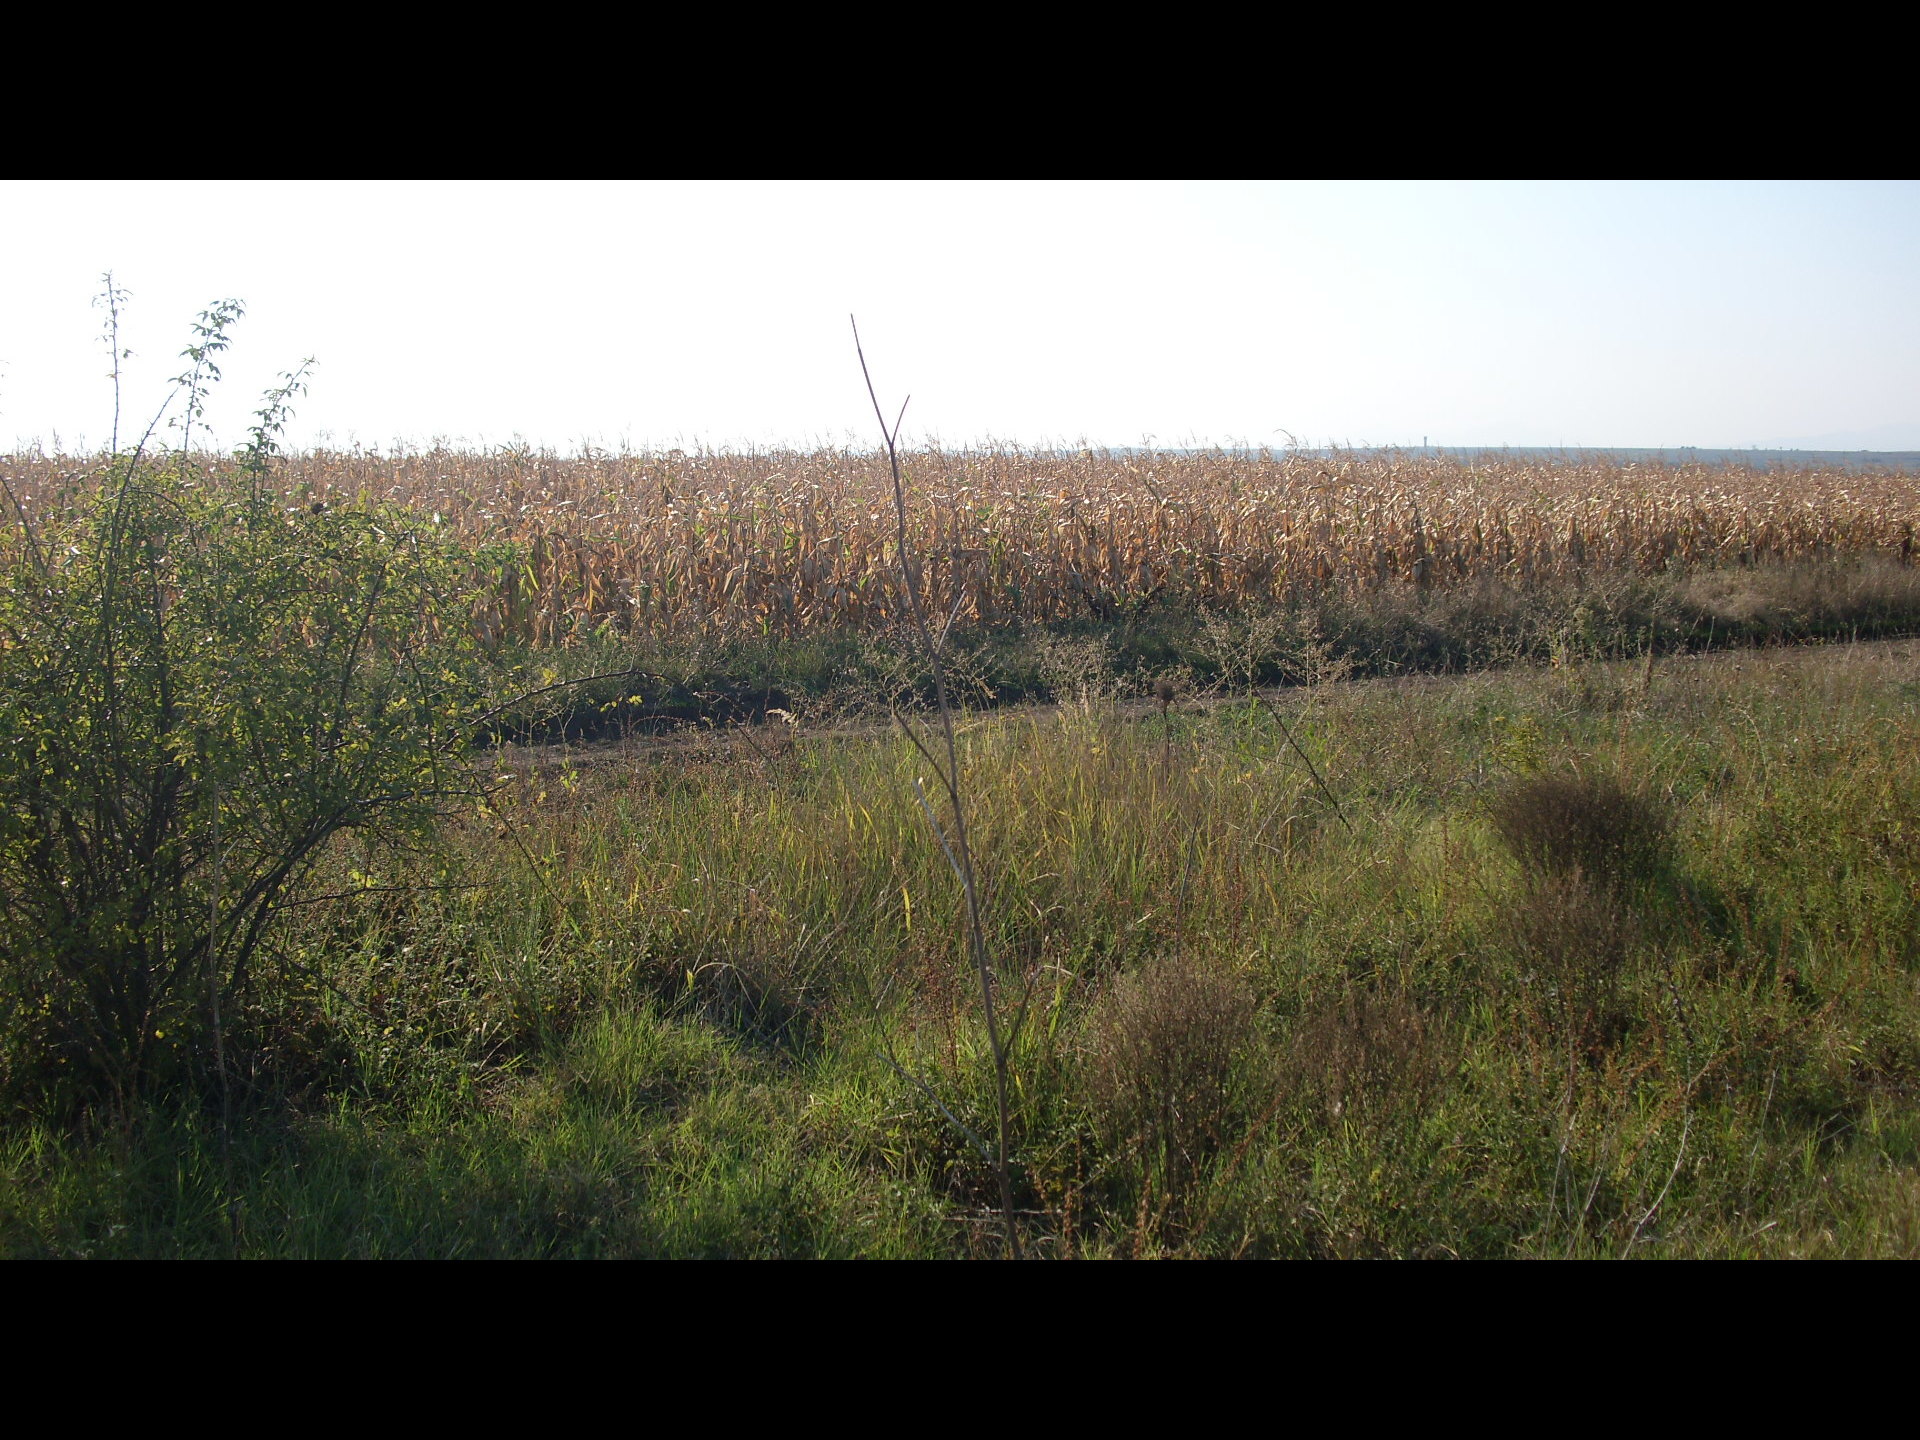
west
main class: Cropland
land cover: Maize
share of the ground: > 75 %
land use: Agriculture (excluding fallow land and kitchen gardens)
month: September
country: BG
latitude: 43.9669
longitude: 22.5613
